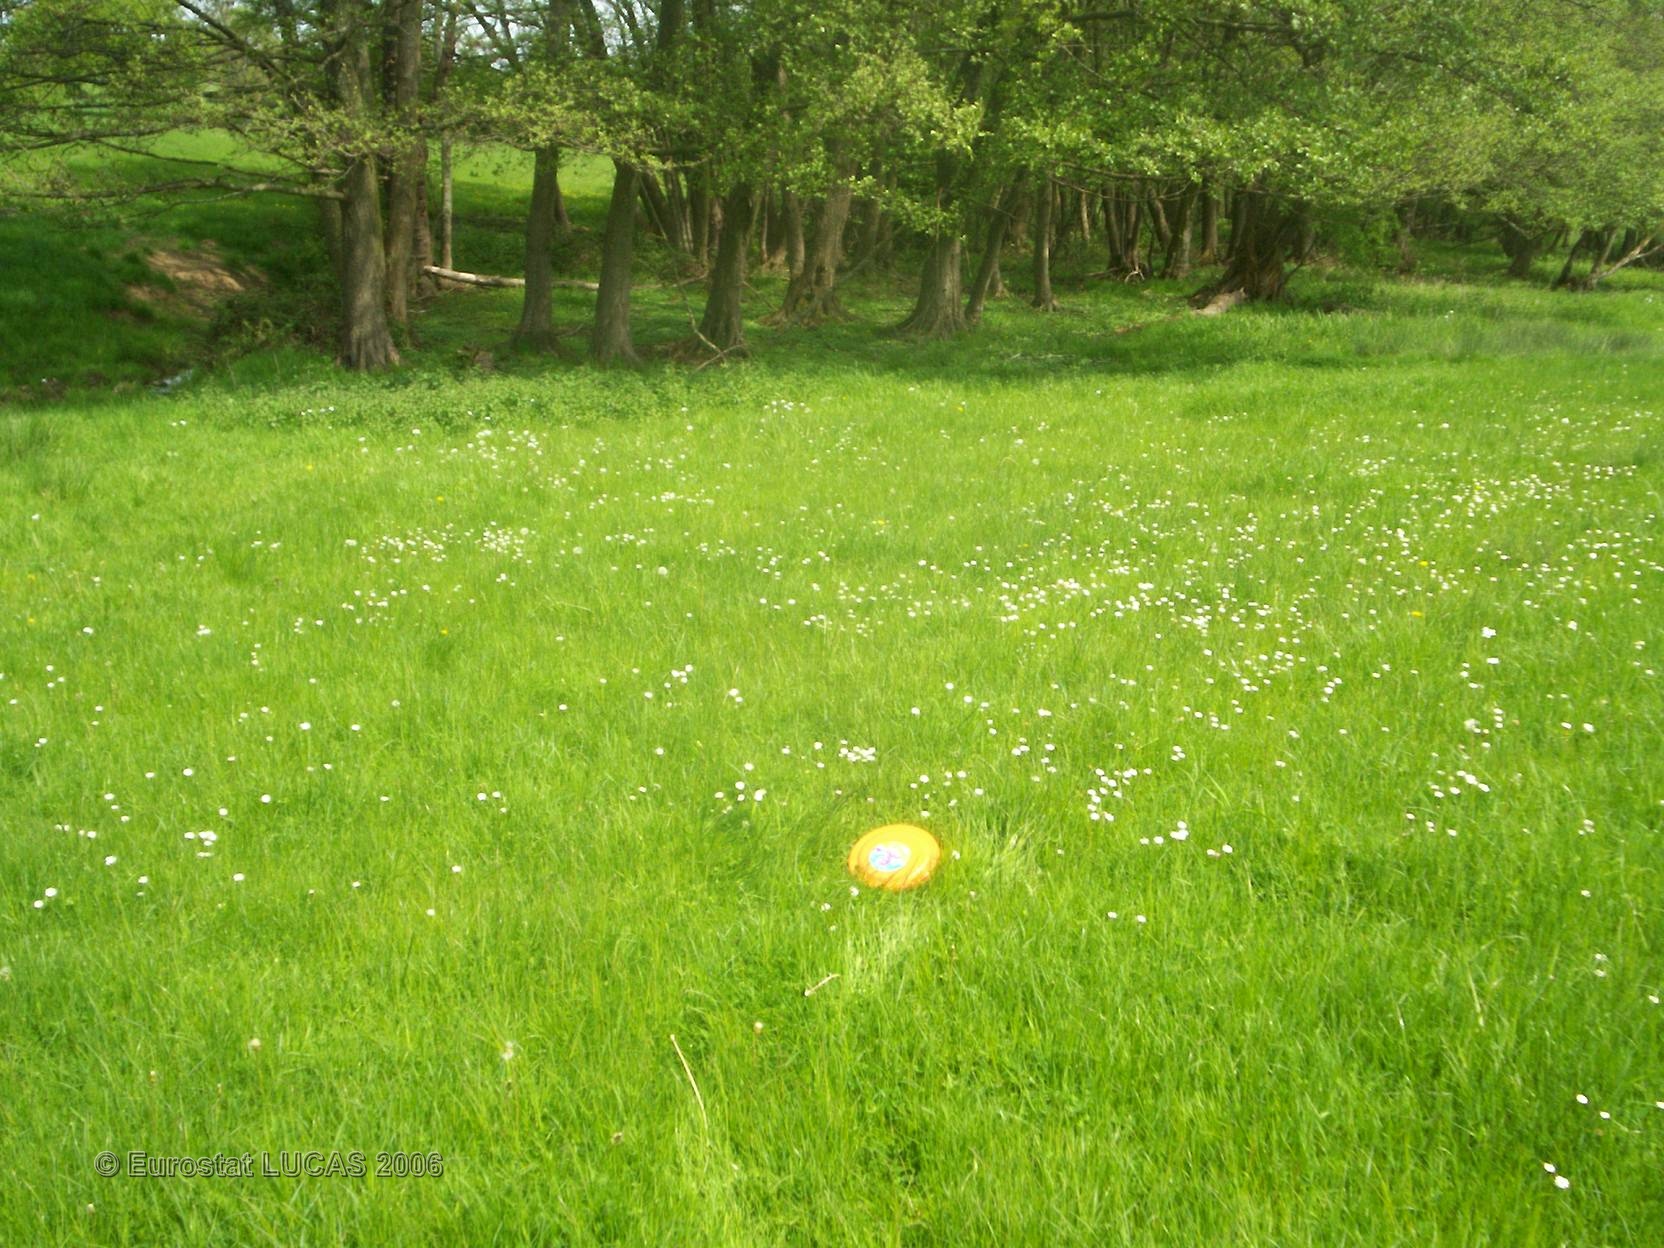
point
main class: Grassland
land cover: Grassland with sparse tree/shrub cover
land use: Agriculture (excluding fallow land and kitchen gardens)
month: May
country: FR
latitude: 46.5276
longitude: 3.1271
